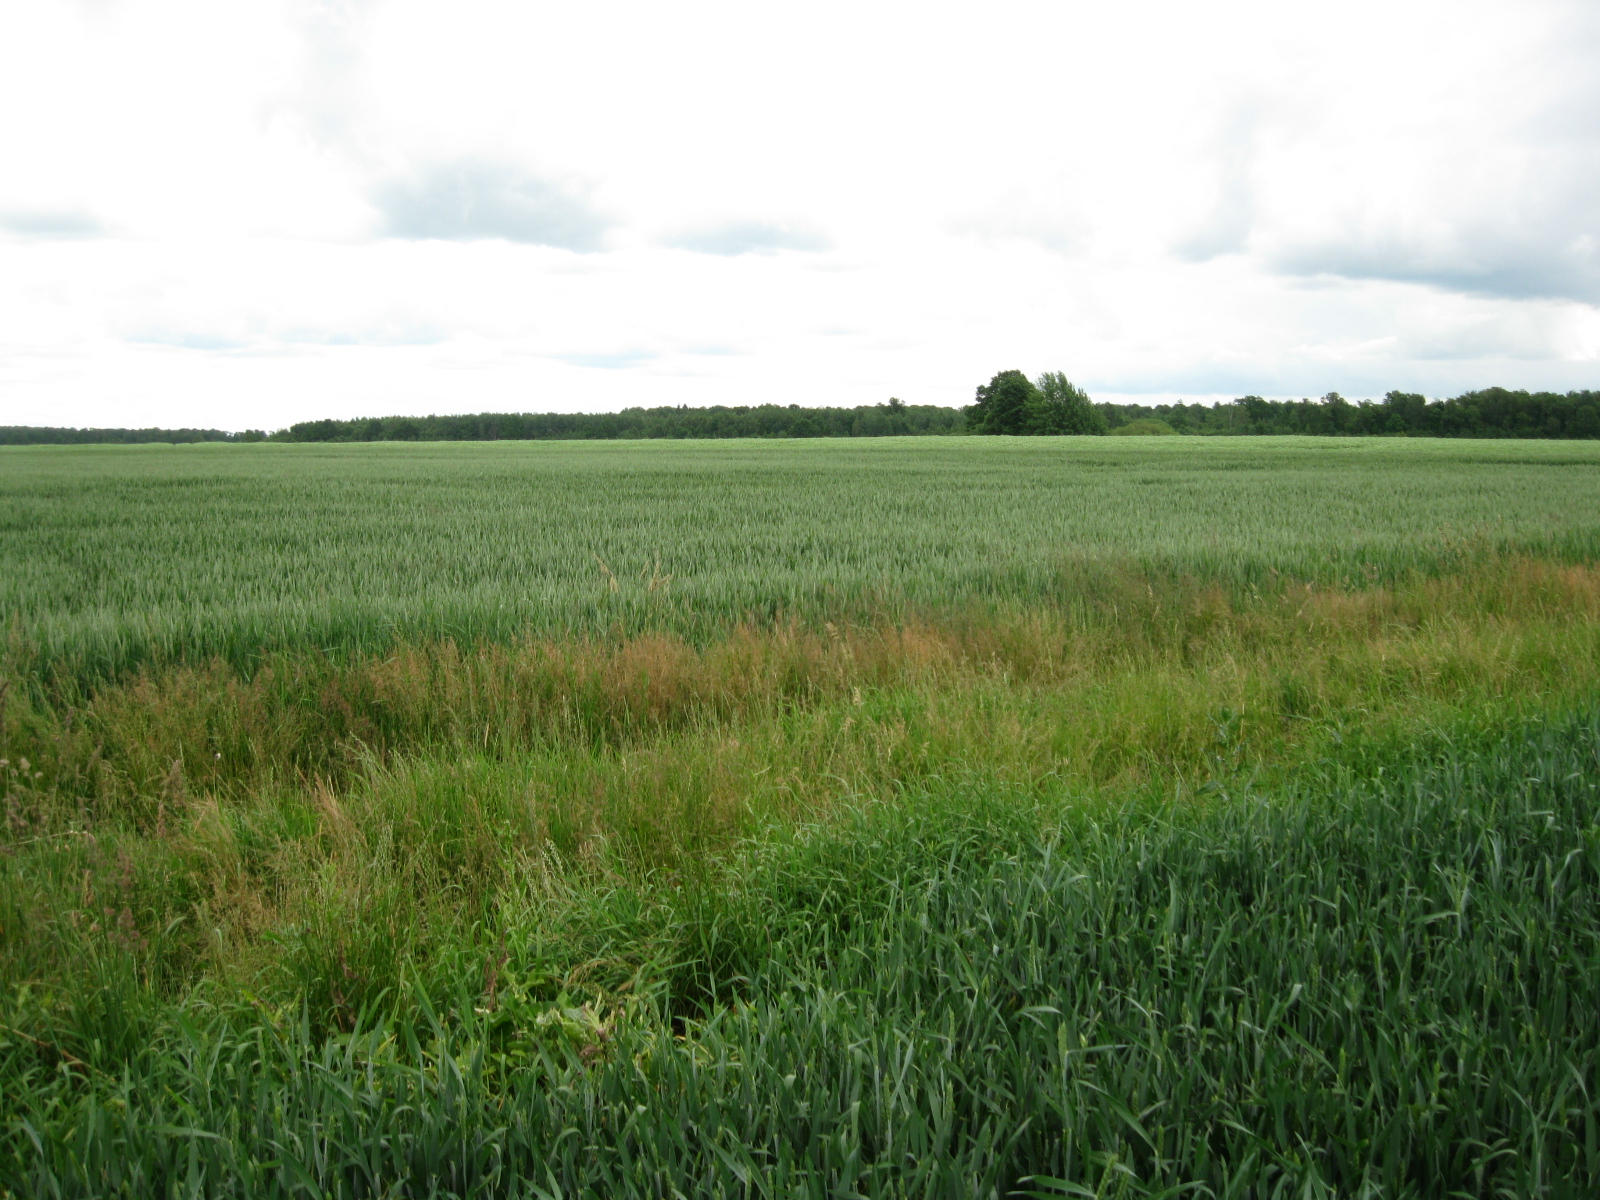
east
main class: Cropland
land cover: Common wheat
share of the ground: > 75 %
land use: Agriculture (excluding fallow land and kitchen gardens)
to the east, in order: Common wheat; Grass margins; Tracks; Grass margins; Common wheat; Grass margins; Tracks; Grass margins; Dry pulses
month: June
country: LT
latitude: 55.3090
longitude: 24.1298
